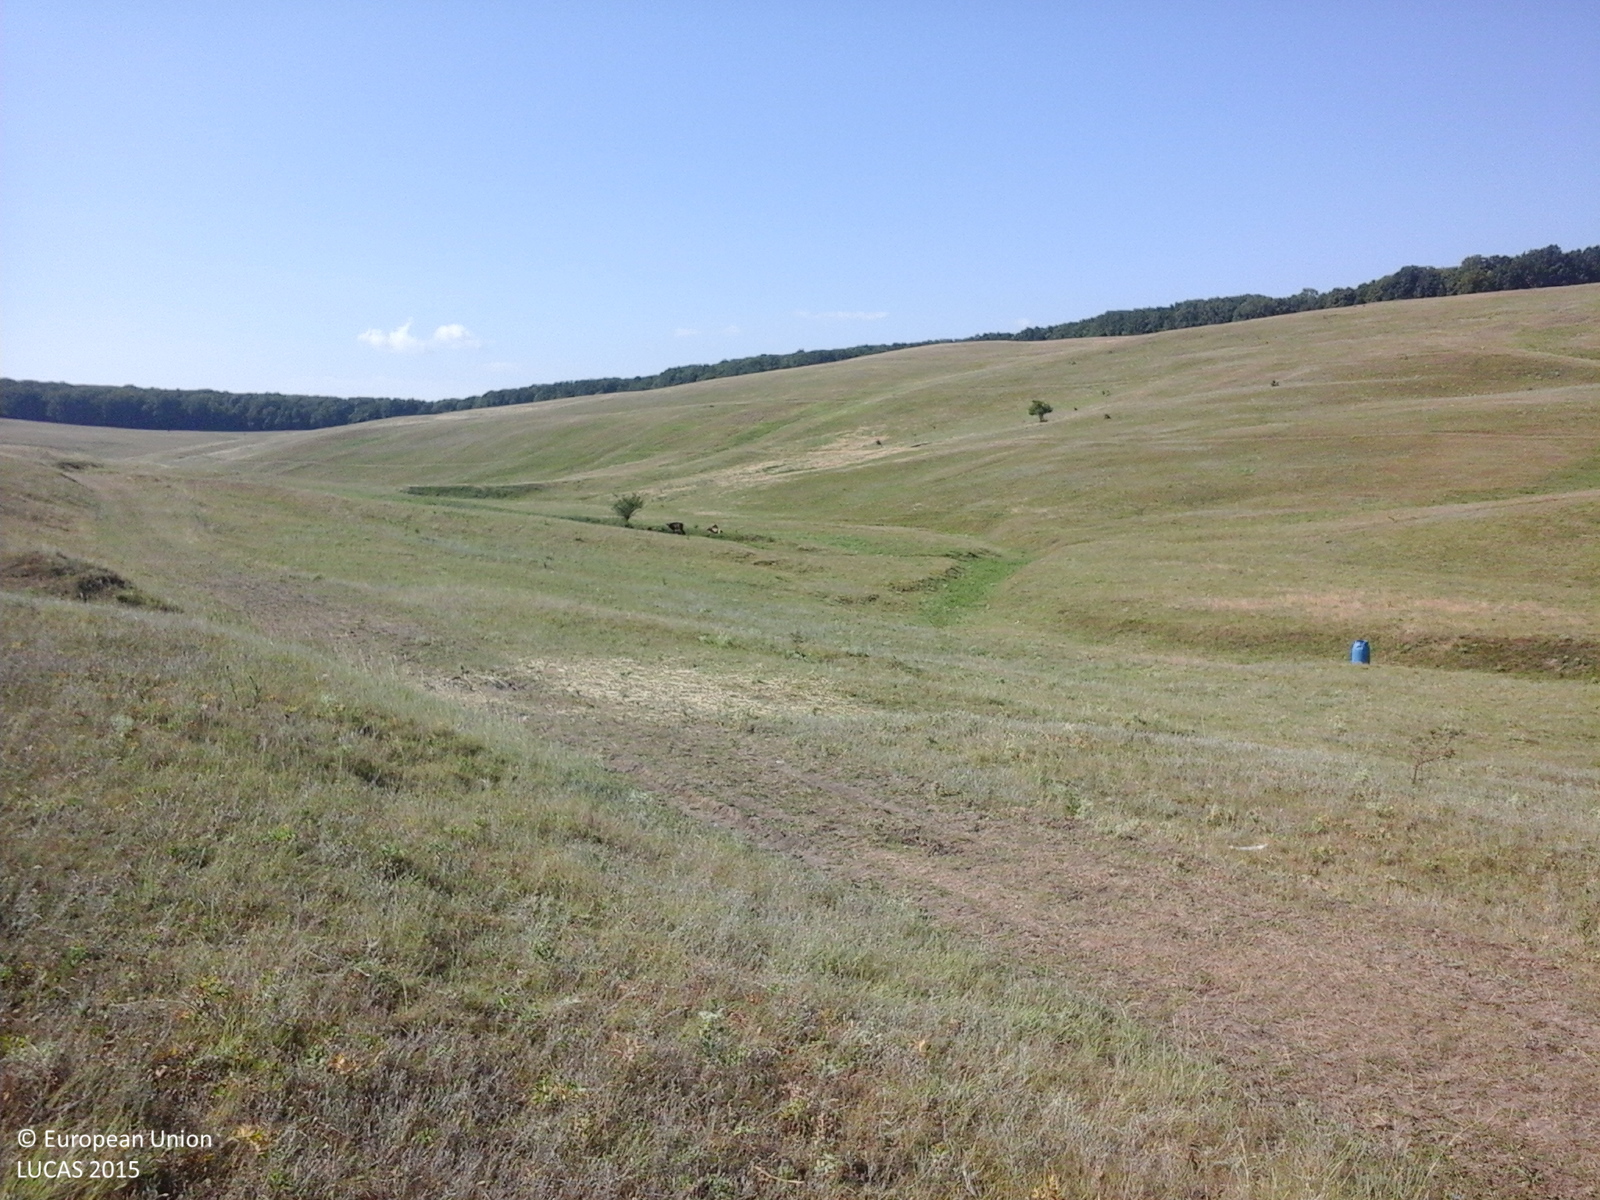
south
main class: Grassland
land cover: Grassland without tree/shrub cover
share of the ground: > 75 %
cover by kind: herbaceous plants 100 %
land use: Agriculture (excluding fallow land and kitchen gardens)
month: July
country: RO
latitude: 46.0696
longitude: 27.7362
